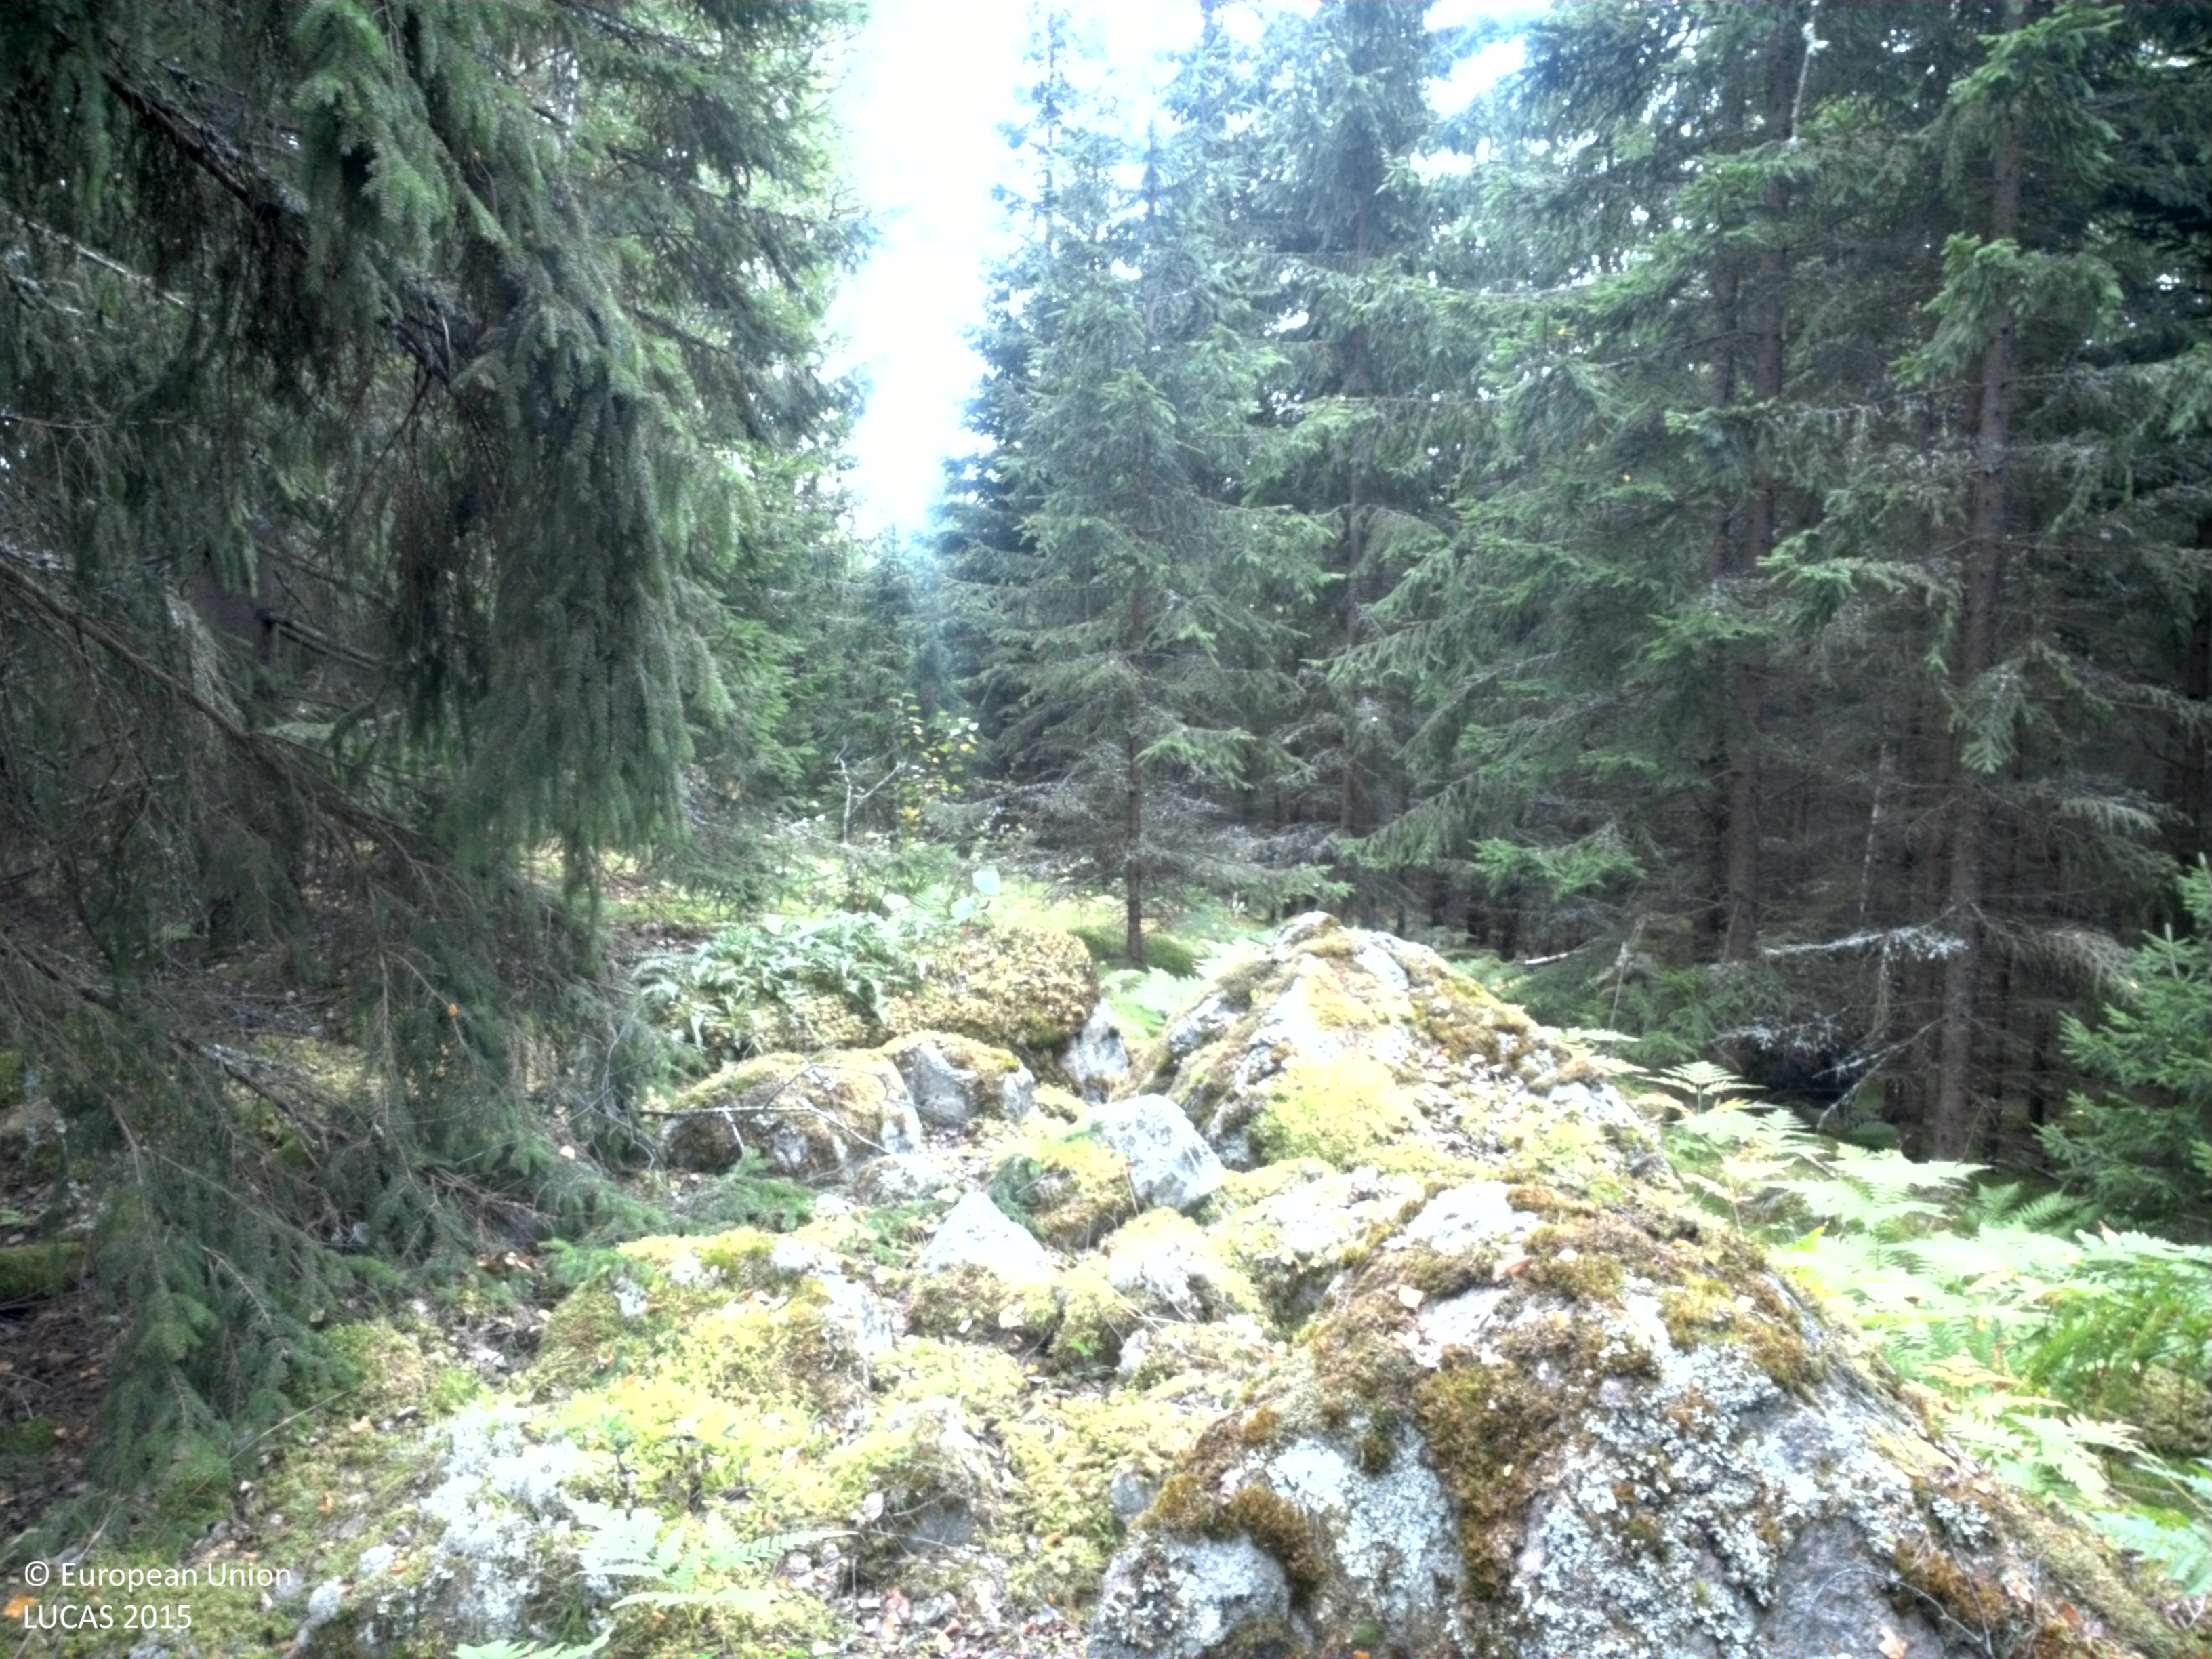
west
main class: Woodland
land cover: Spruce dominated mixed woodland
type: boreal forest
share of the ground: 50 - 75 %
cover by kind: lichens and mosses 35 %, coniferous forest trees 30 %, broadleaved forest trees 25 %, herbaceous plants 10 %
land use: Forestry
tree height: > 5 m
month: August
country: SE
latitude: 59.5271
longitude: 17.1894
